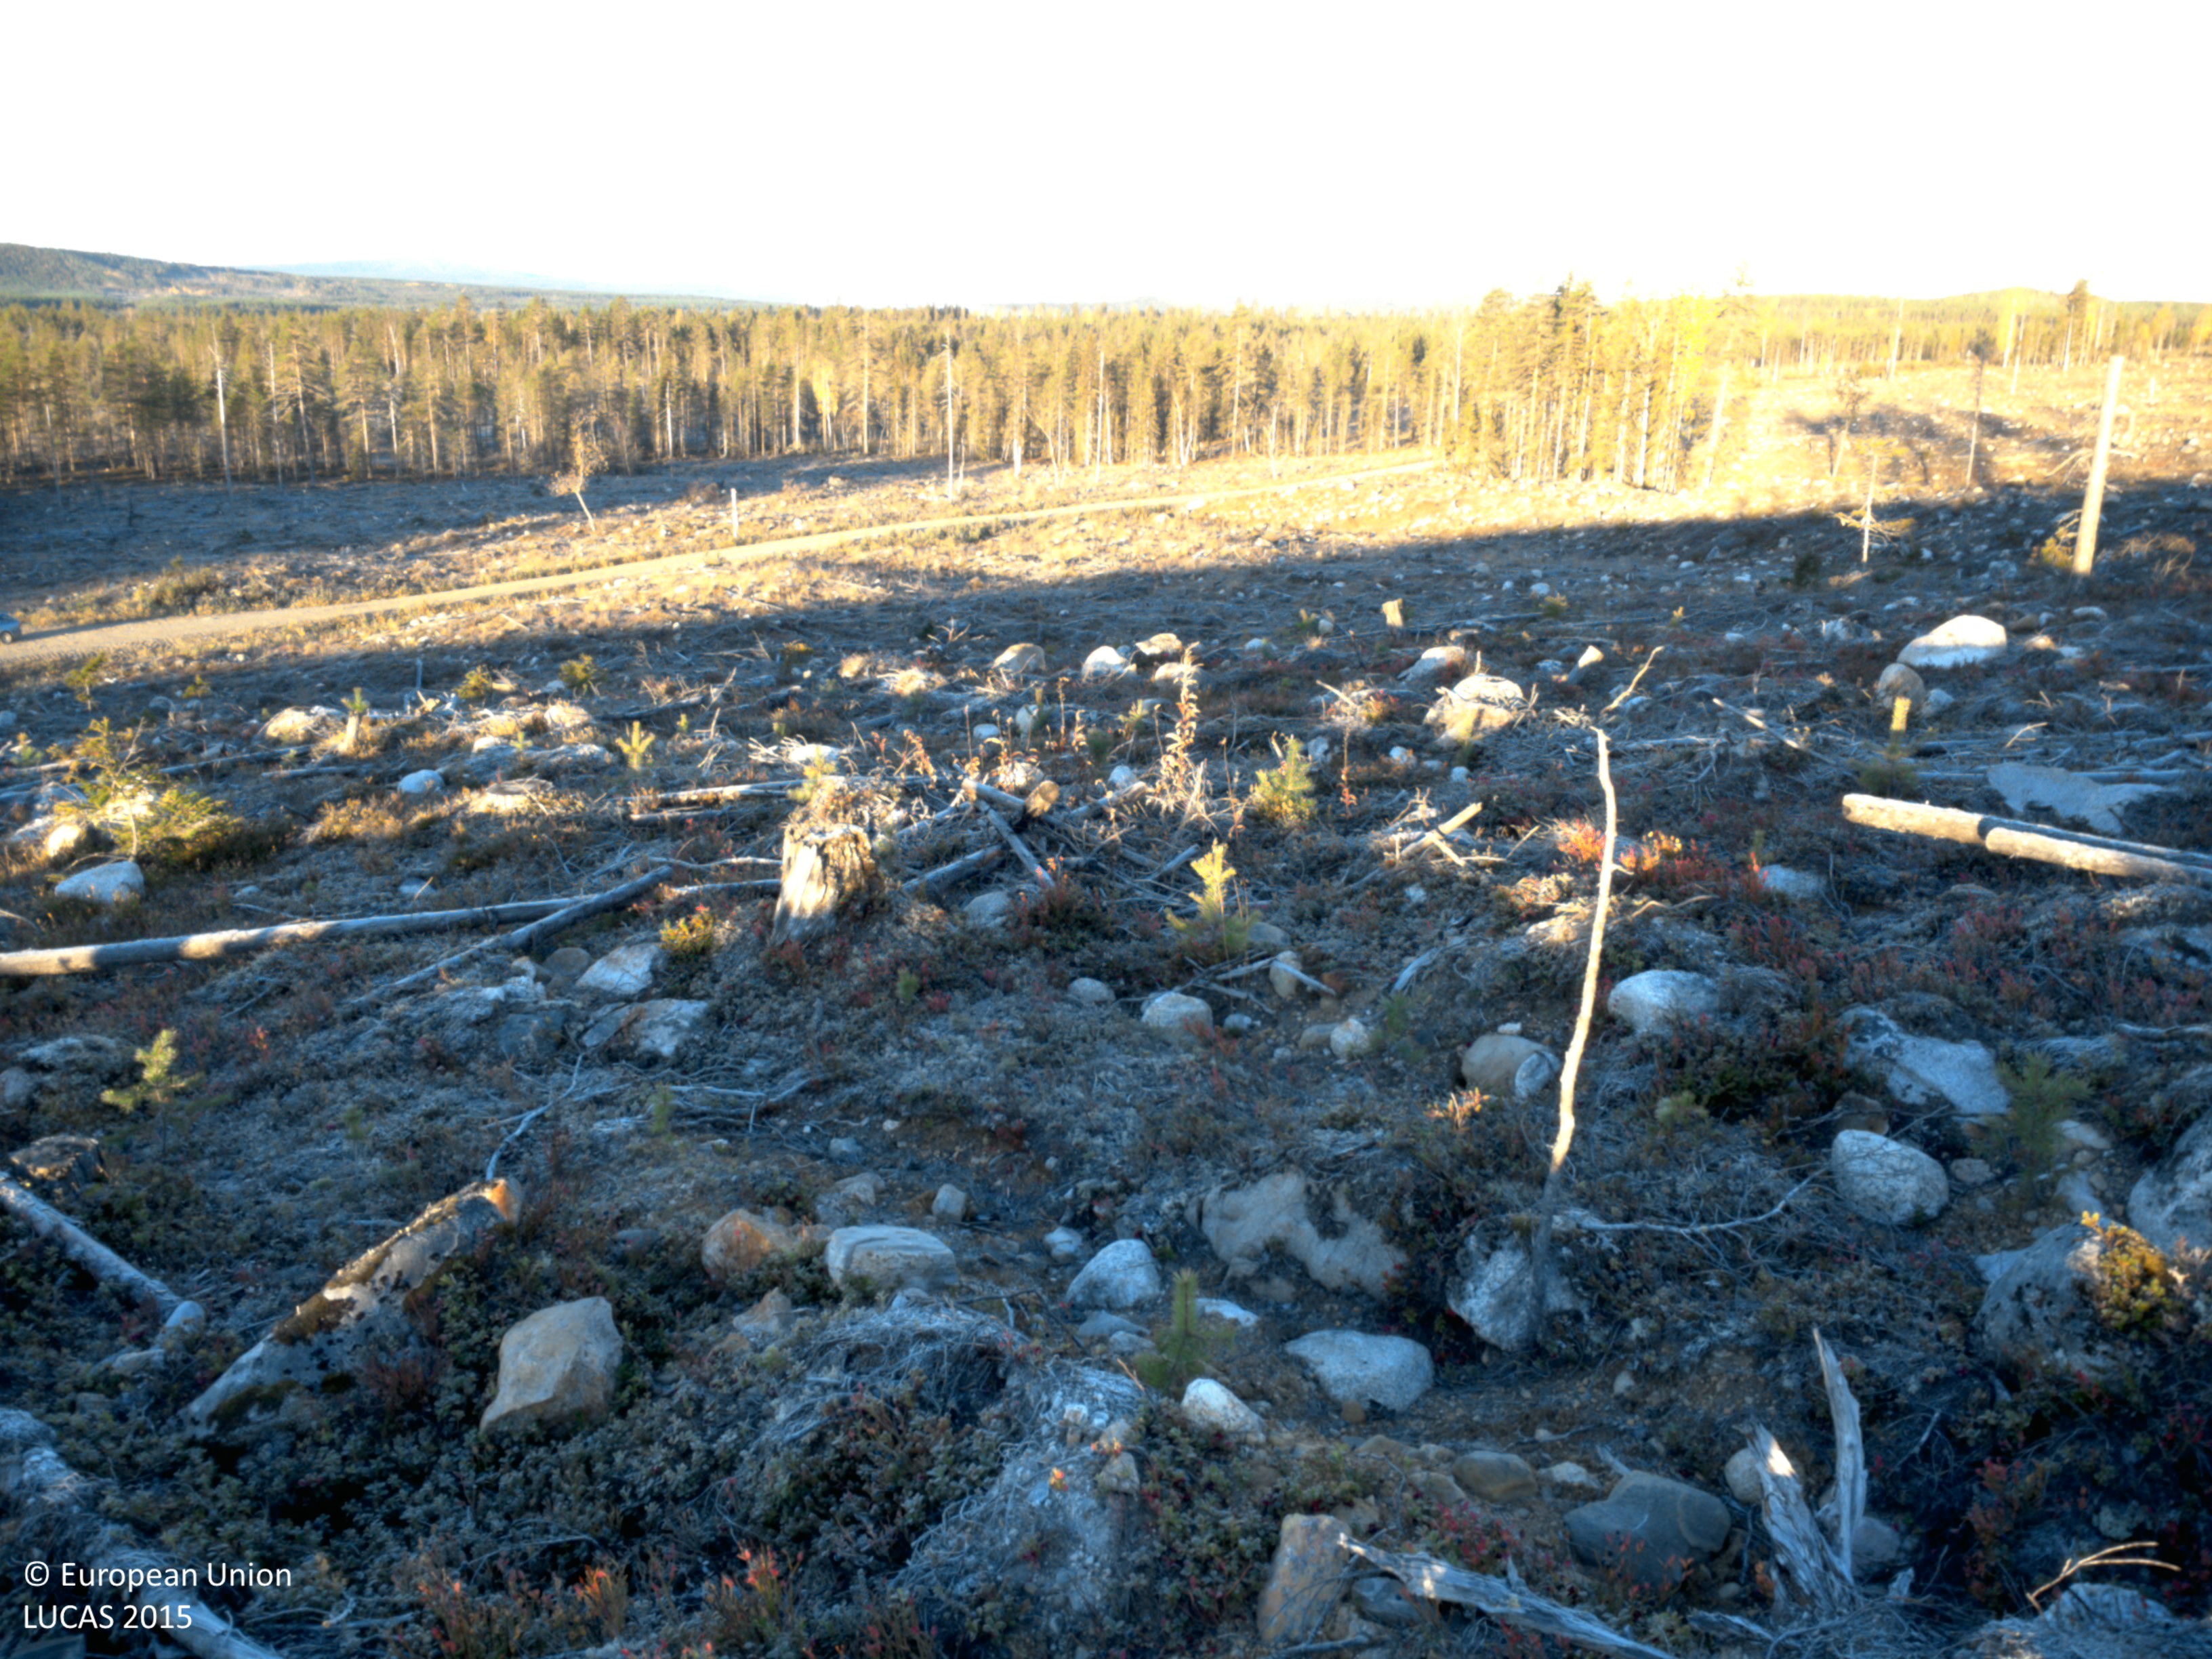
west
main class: Shrubland
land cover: Shrubland with sparse tree cover
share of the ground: 25 - 50 %
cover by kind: shrubs 50 %, consolidated bare surface 20 %, herbaceous plants 15 %, unconsolidated bare surface 10 %, coniferous forest trees 5 %
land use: Forestry
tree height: < 5 m
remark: Clear cut
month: October
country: SE
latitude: 64.7090
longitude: 17.9169
